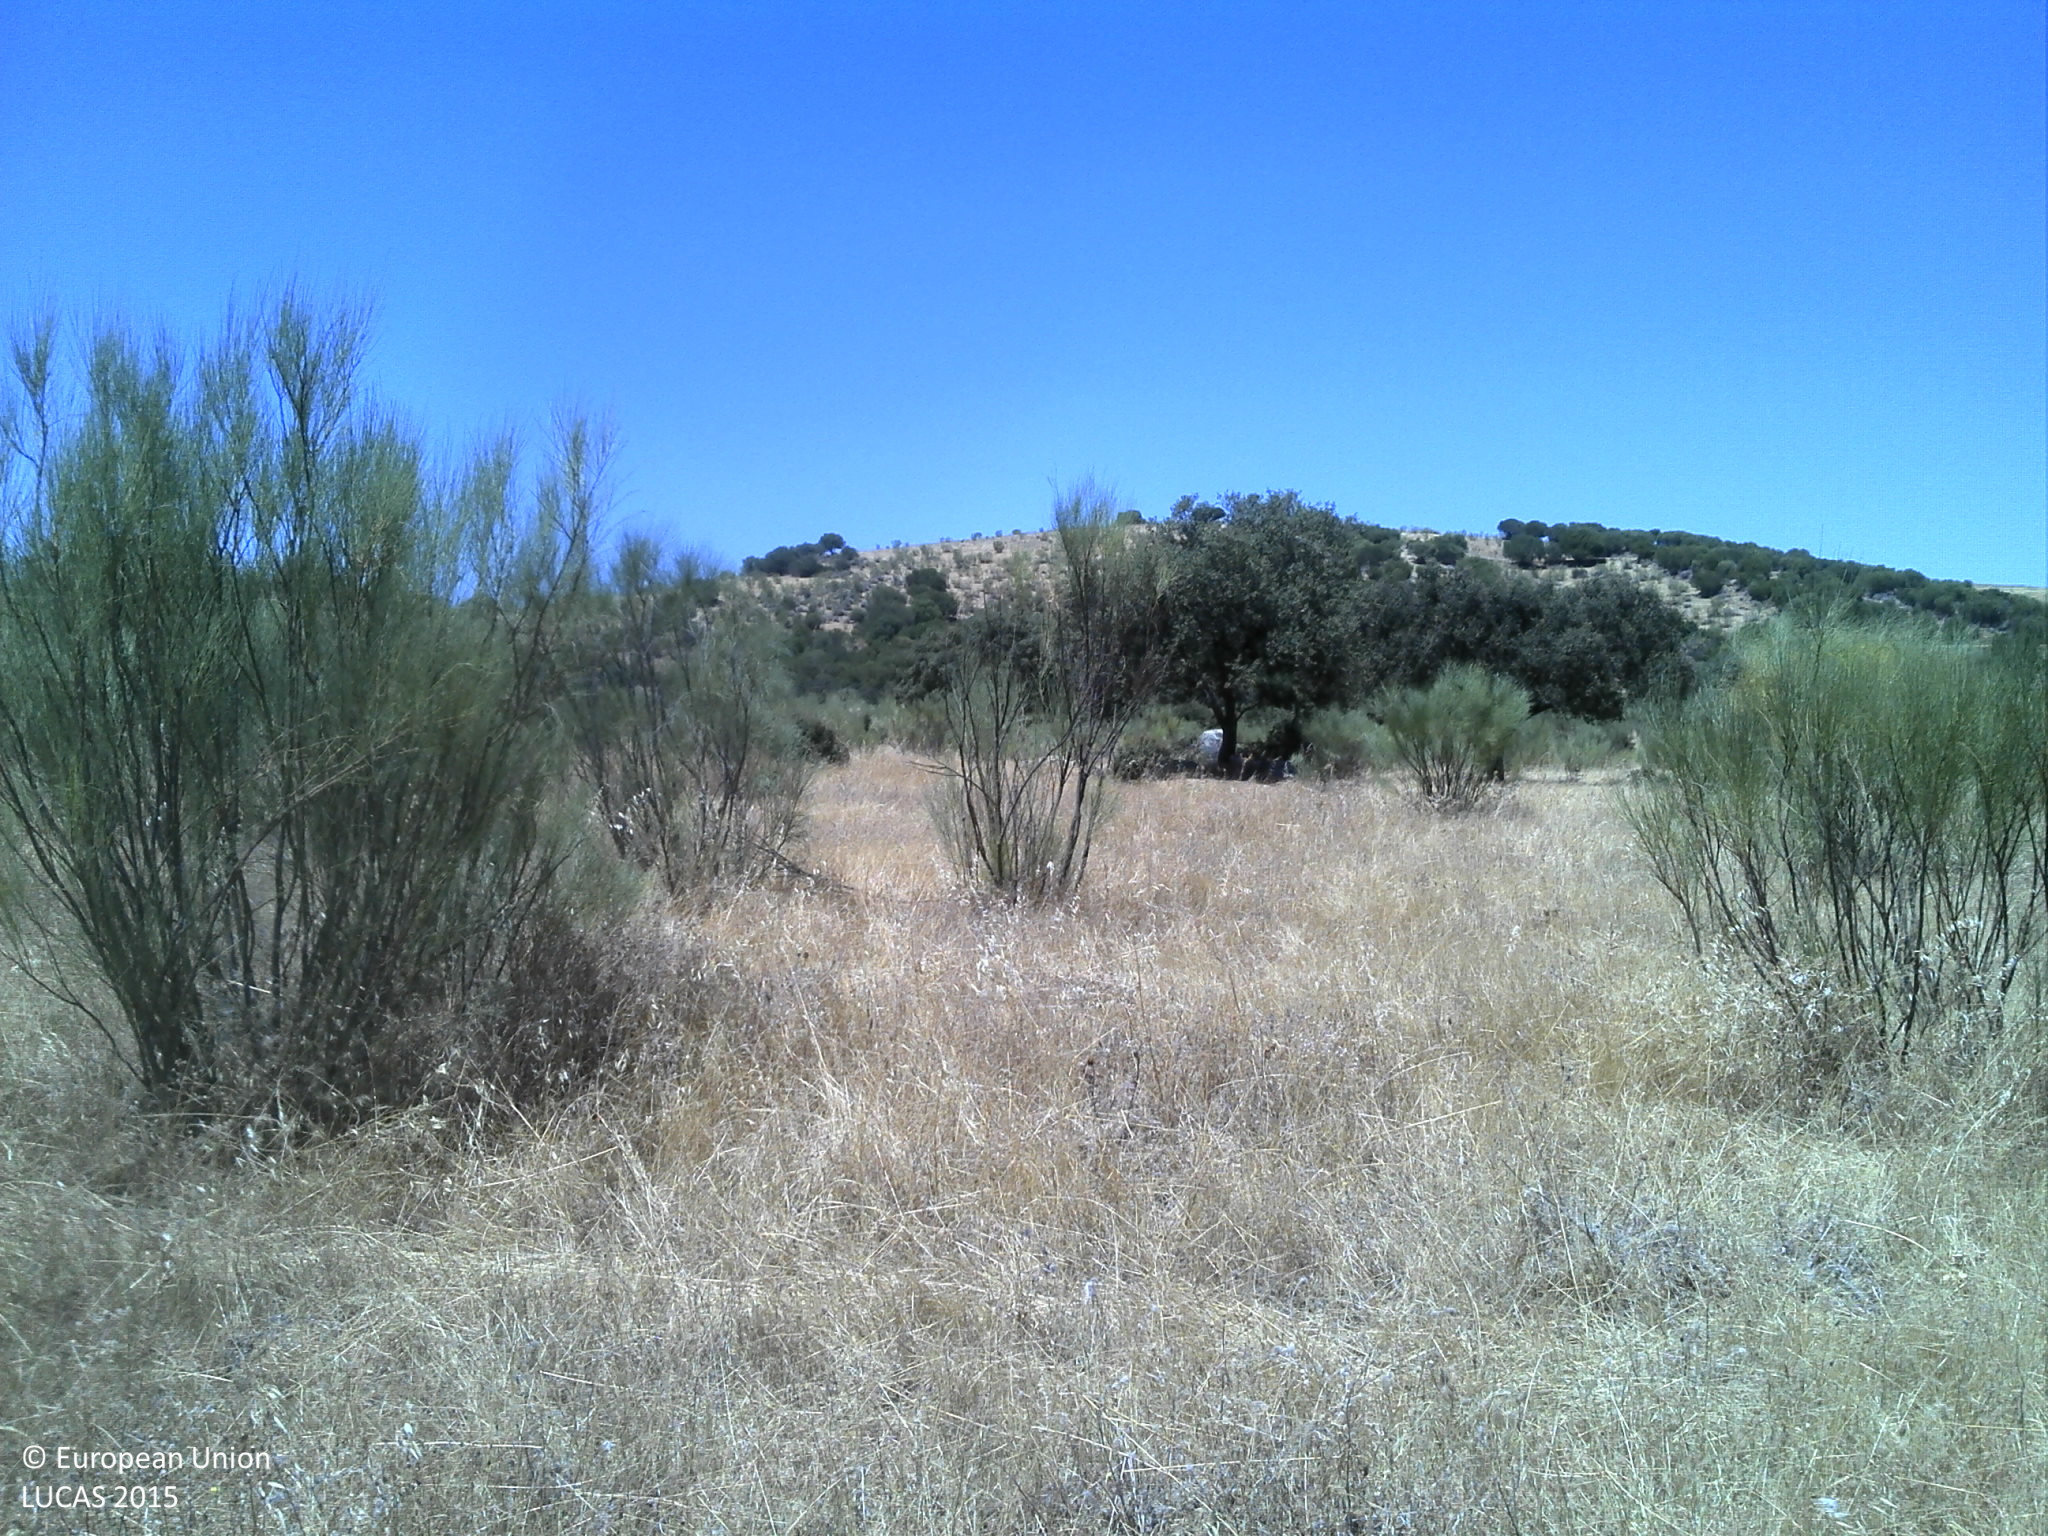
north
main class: Shrubland
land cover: Shrubland without tree cover
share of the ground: 25 - 50 %
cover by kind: herbaceous plants 50 %, shrubs 25 %, unconsolidated bare surface 25 %
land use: Agriculture (excluding fallow land and kitchen gardens)
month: July
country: PT
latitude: 38.9884
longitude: -7.1270
